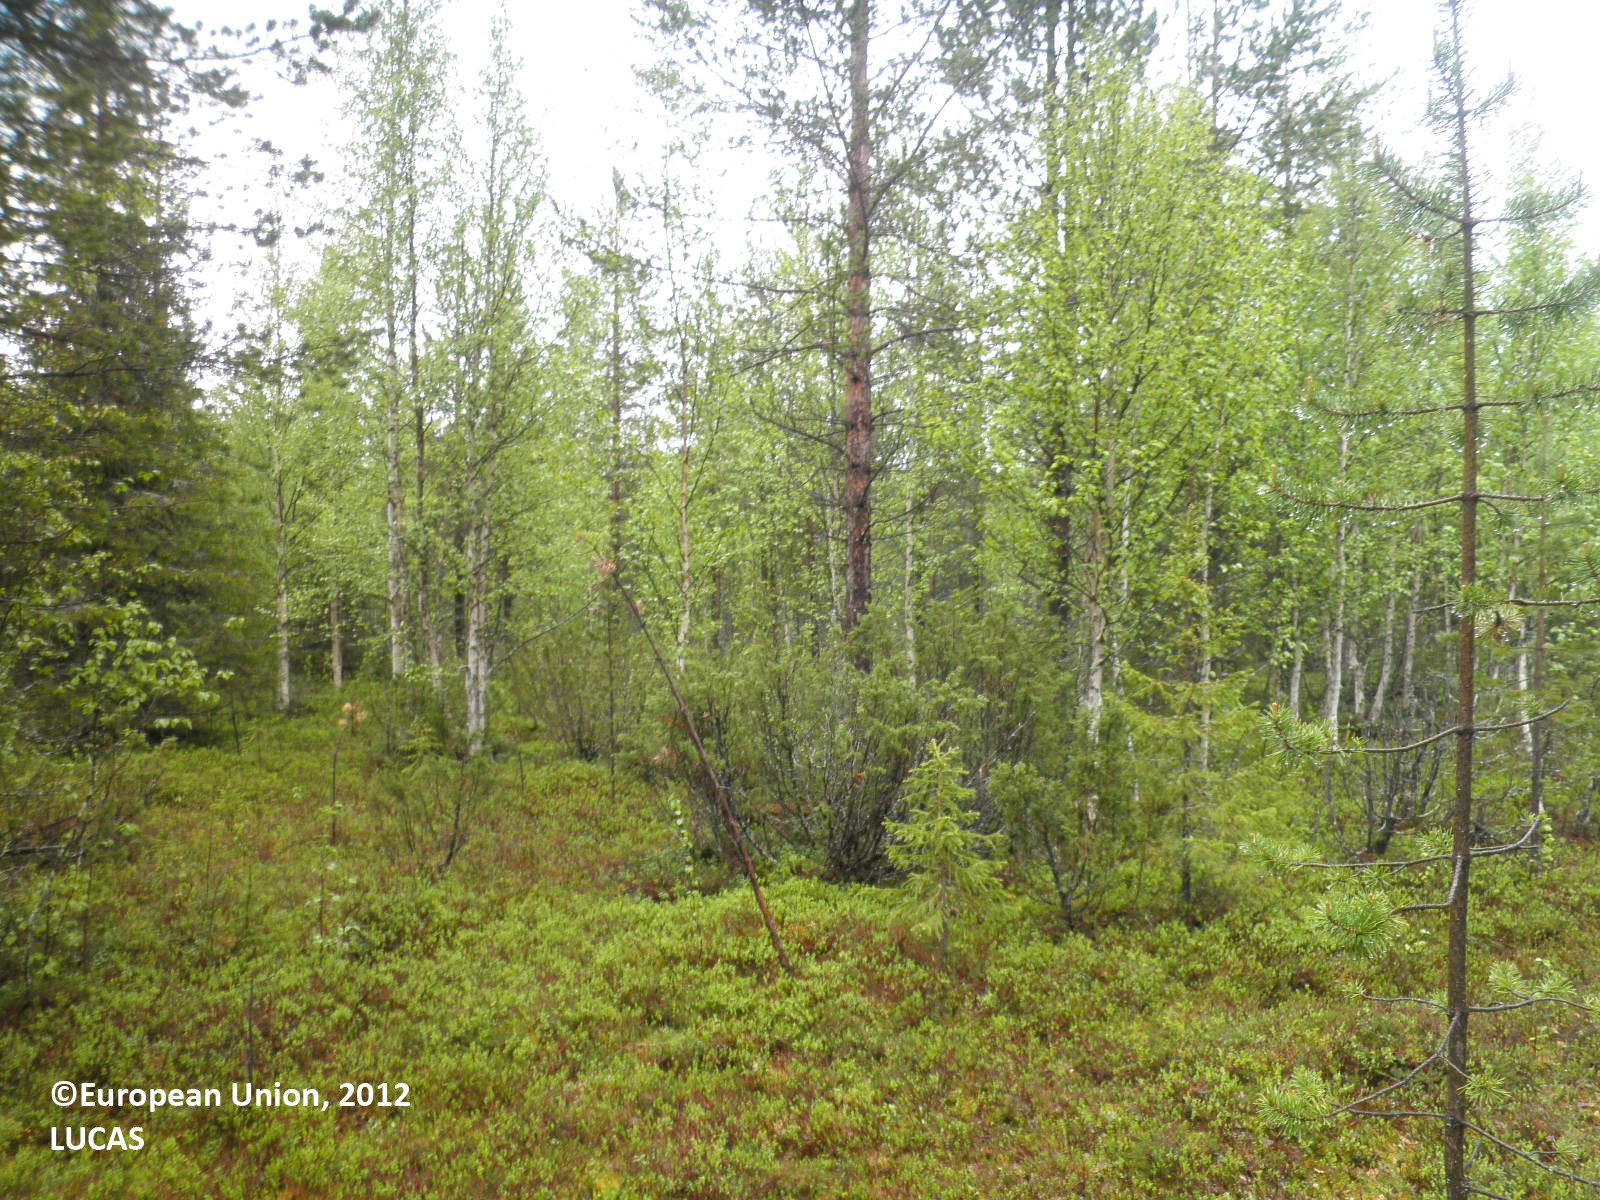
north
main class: Woodland
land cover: Pine dominated mixed woodland
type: boreal forest
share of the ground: > 75 %
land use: Forestry
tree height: > 5 m
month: June
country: FI
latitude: 68.0204
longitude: 25.7274
